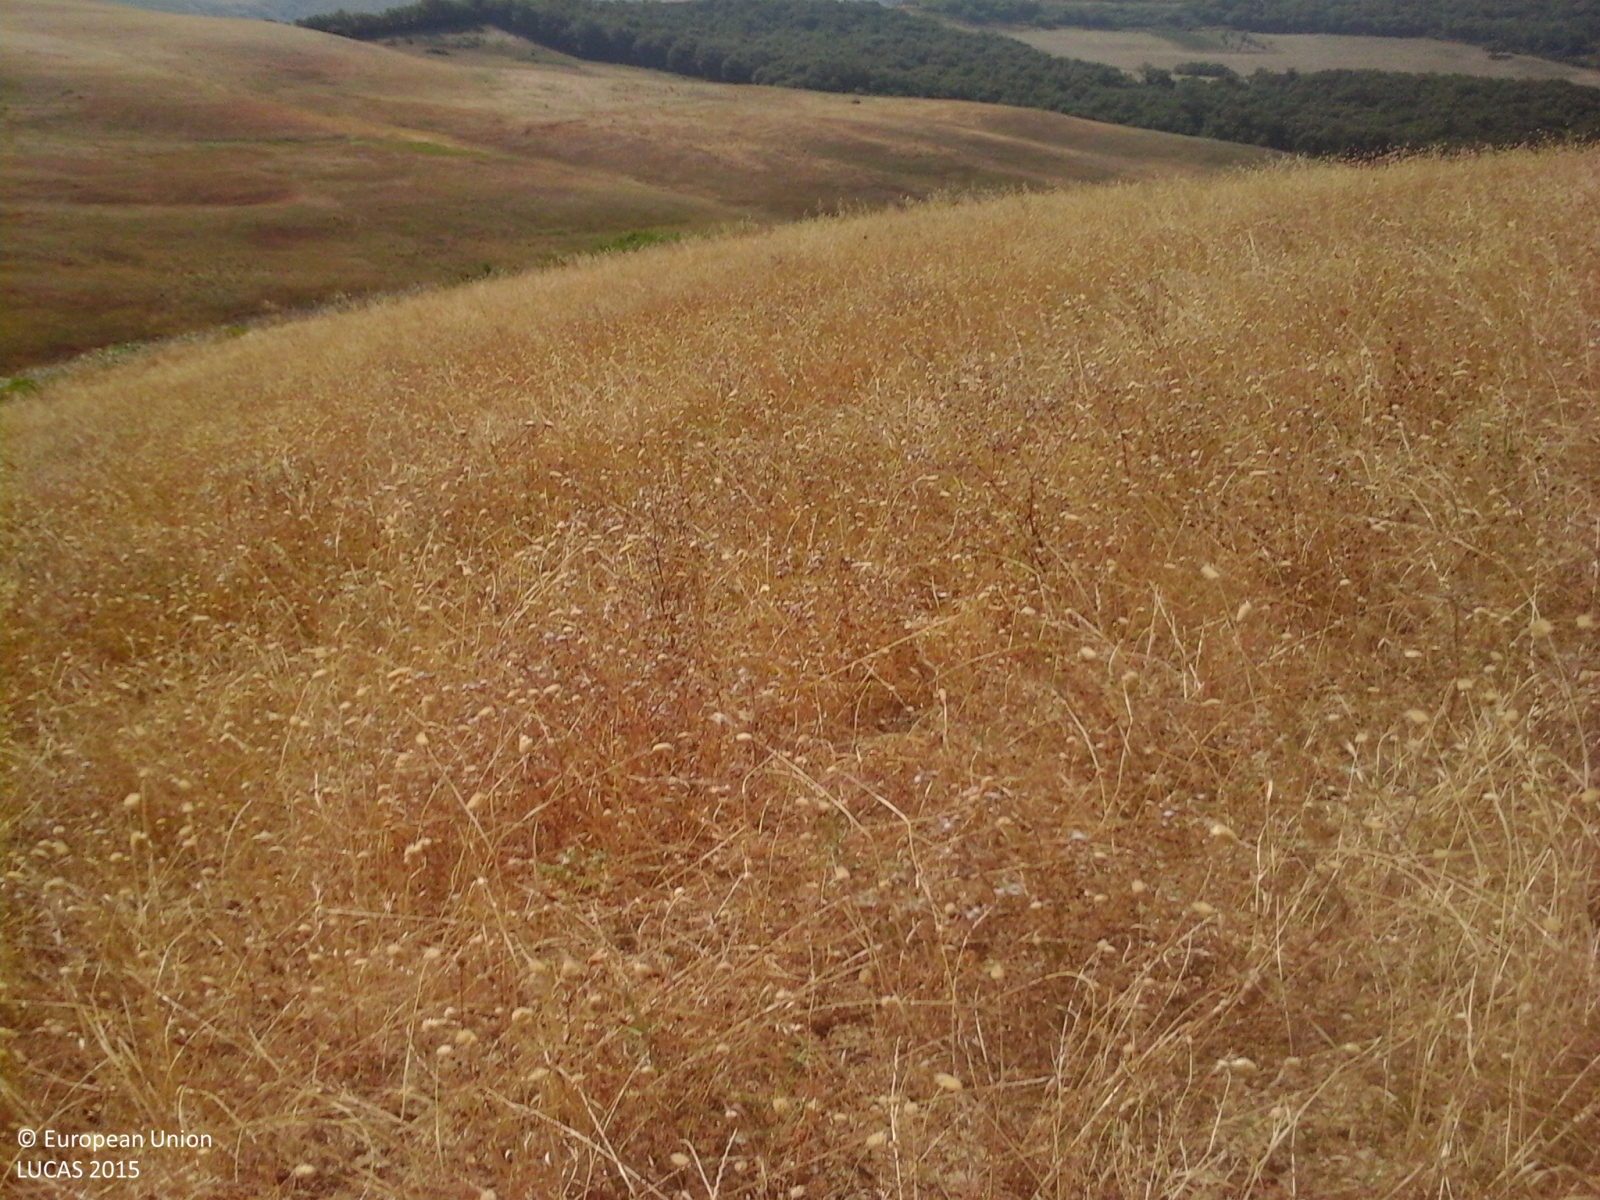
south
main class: Cropland
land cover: Temporary grasslands
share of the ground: > 75 %
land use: Agriculture (excluding fallow land and kitchen gardens)
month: July
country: IT
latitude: 43.1120
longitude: 11.5315
